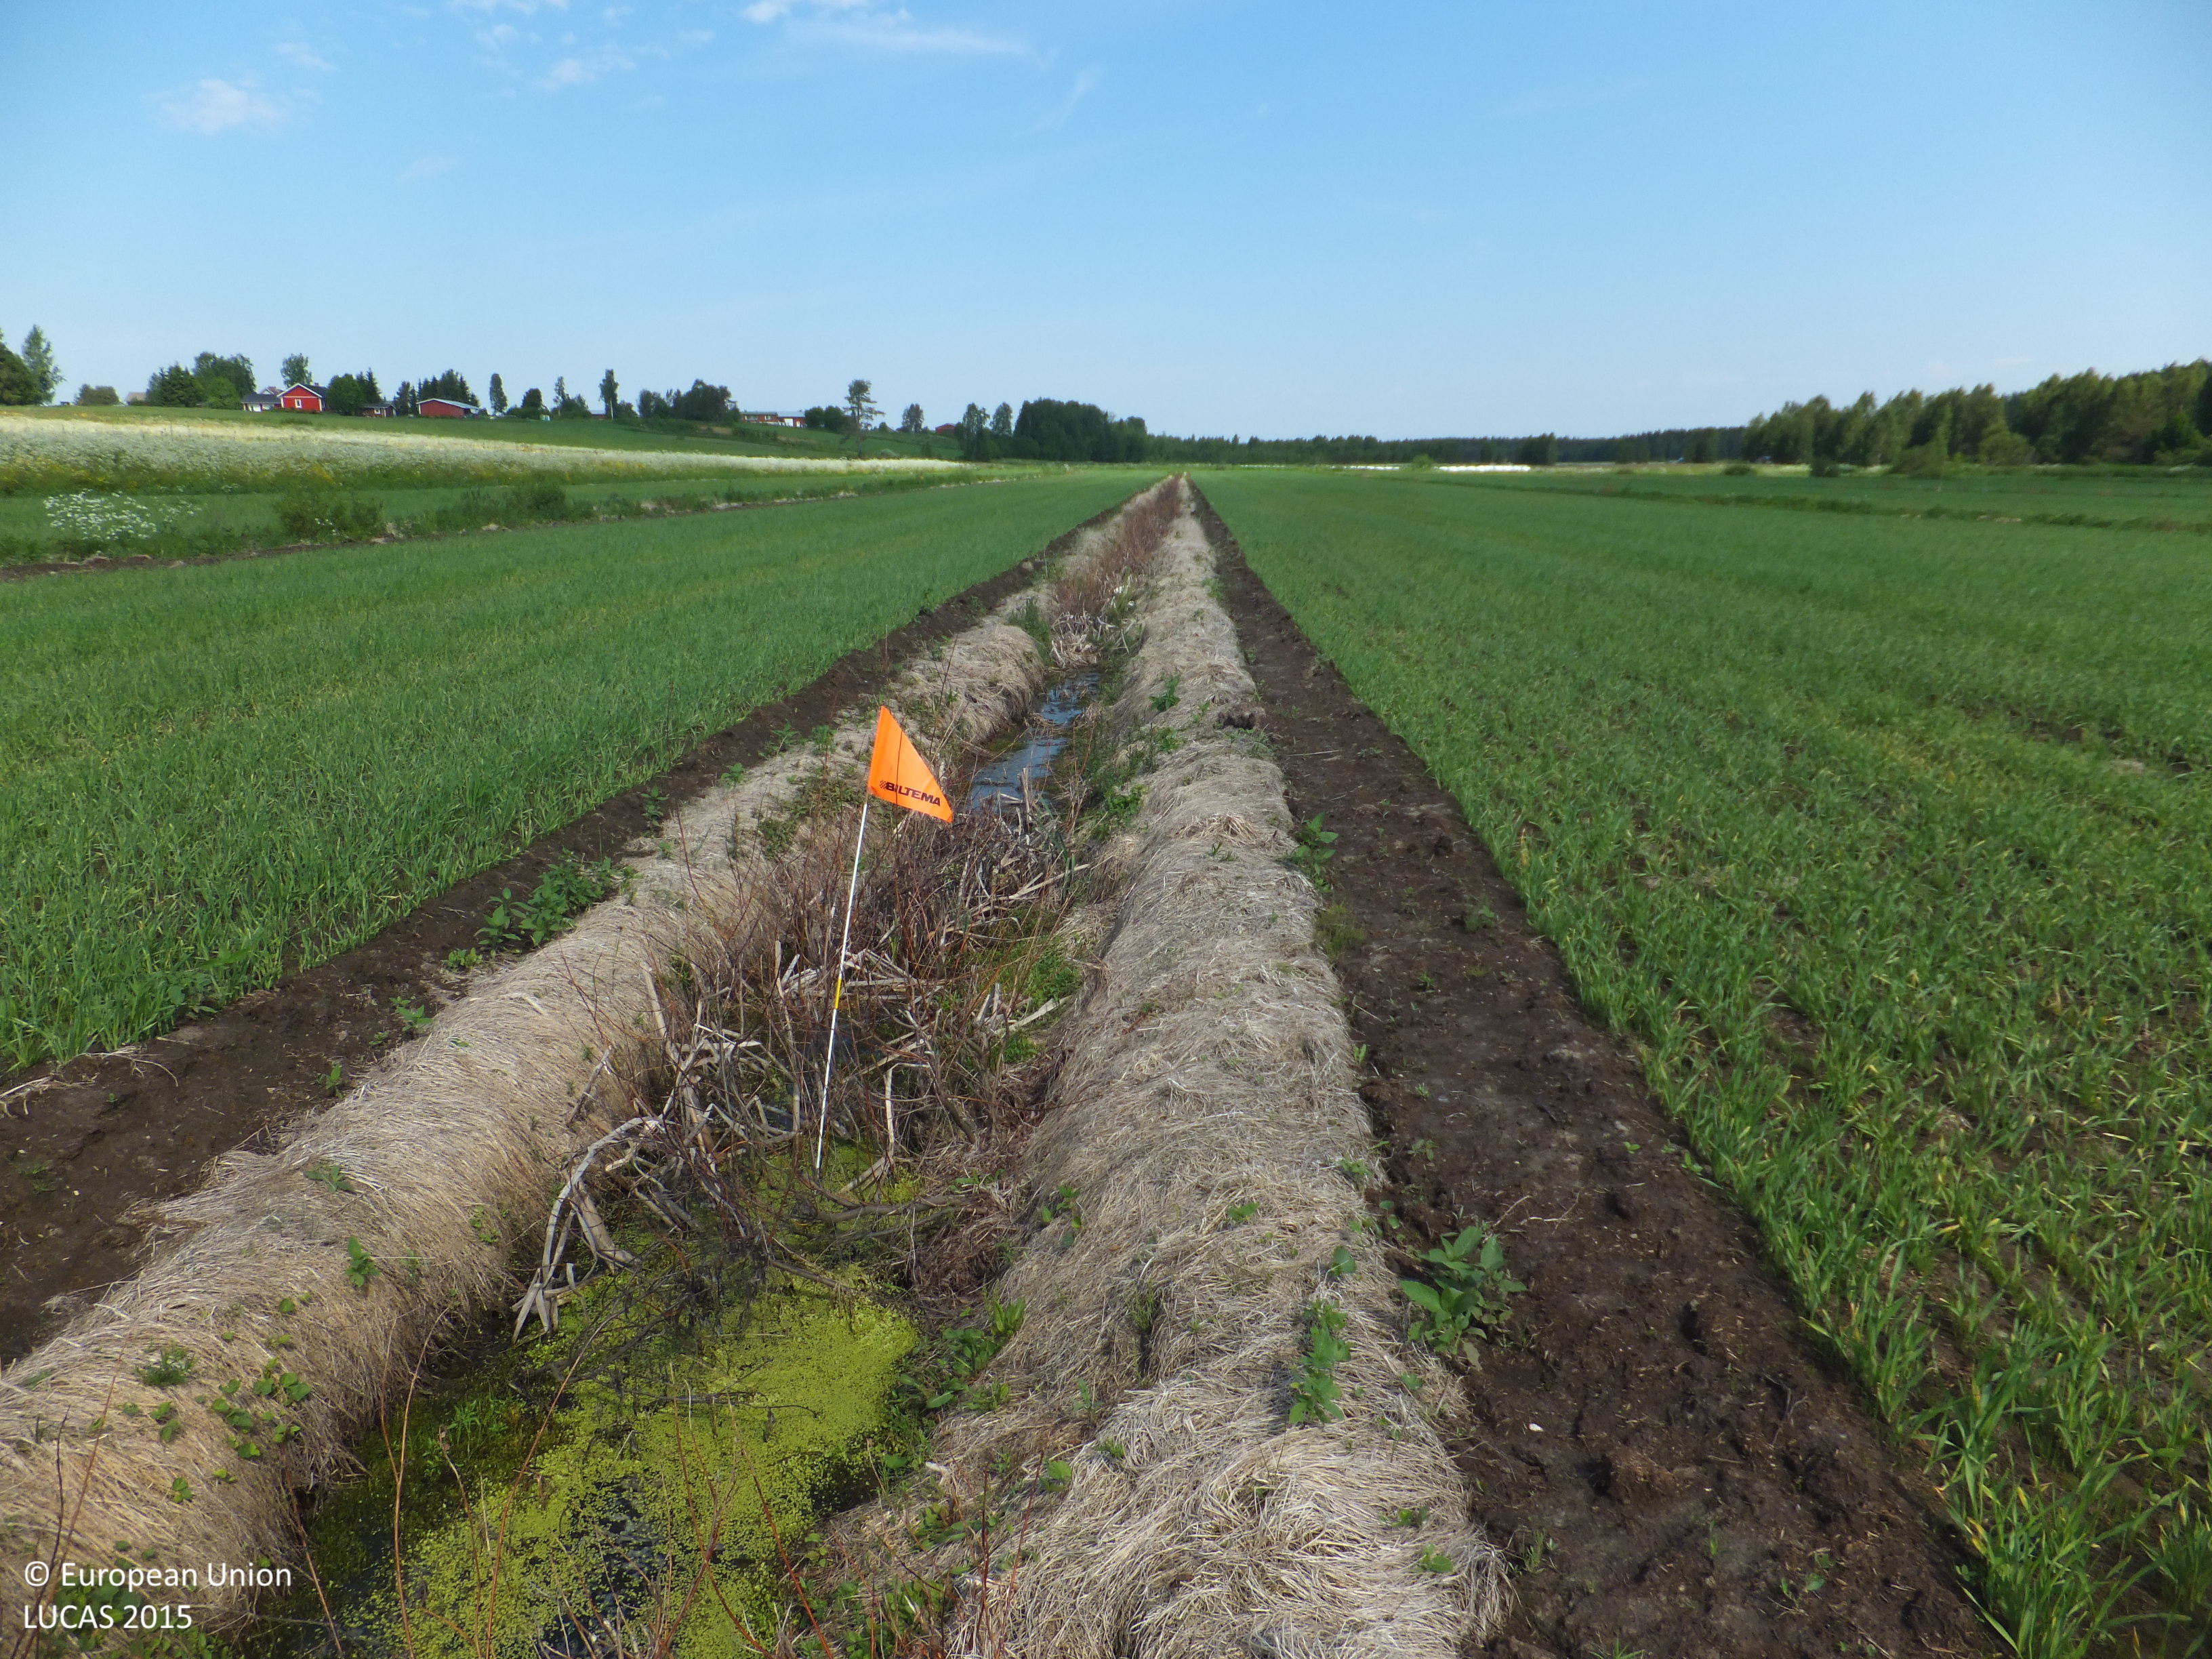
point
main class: Cropland
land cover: Barley
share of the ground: 25 - 50 %
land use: Agriculture (excluding fallow land and kitchen gardens)
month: July
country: FI
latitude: 63.2625
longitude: 23.7554
